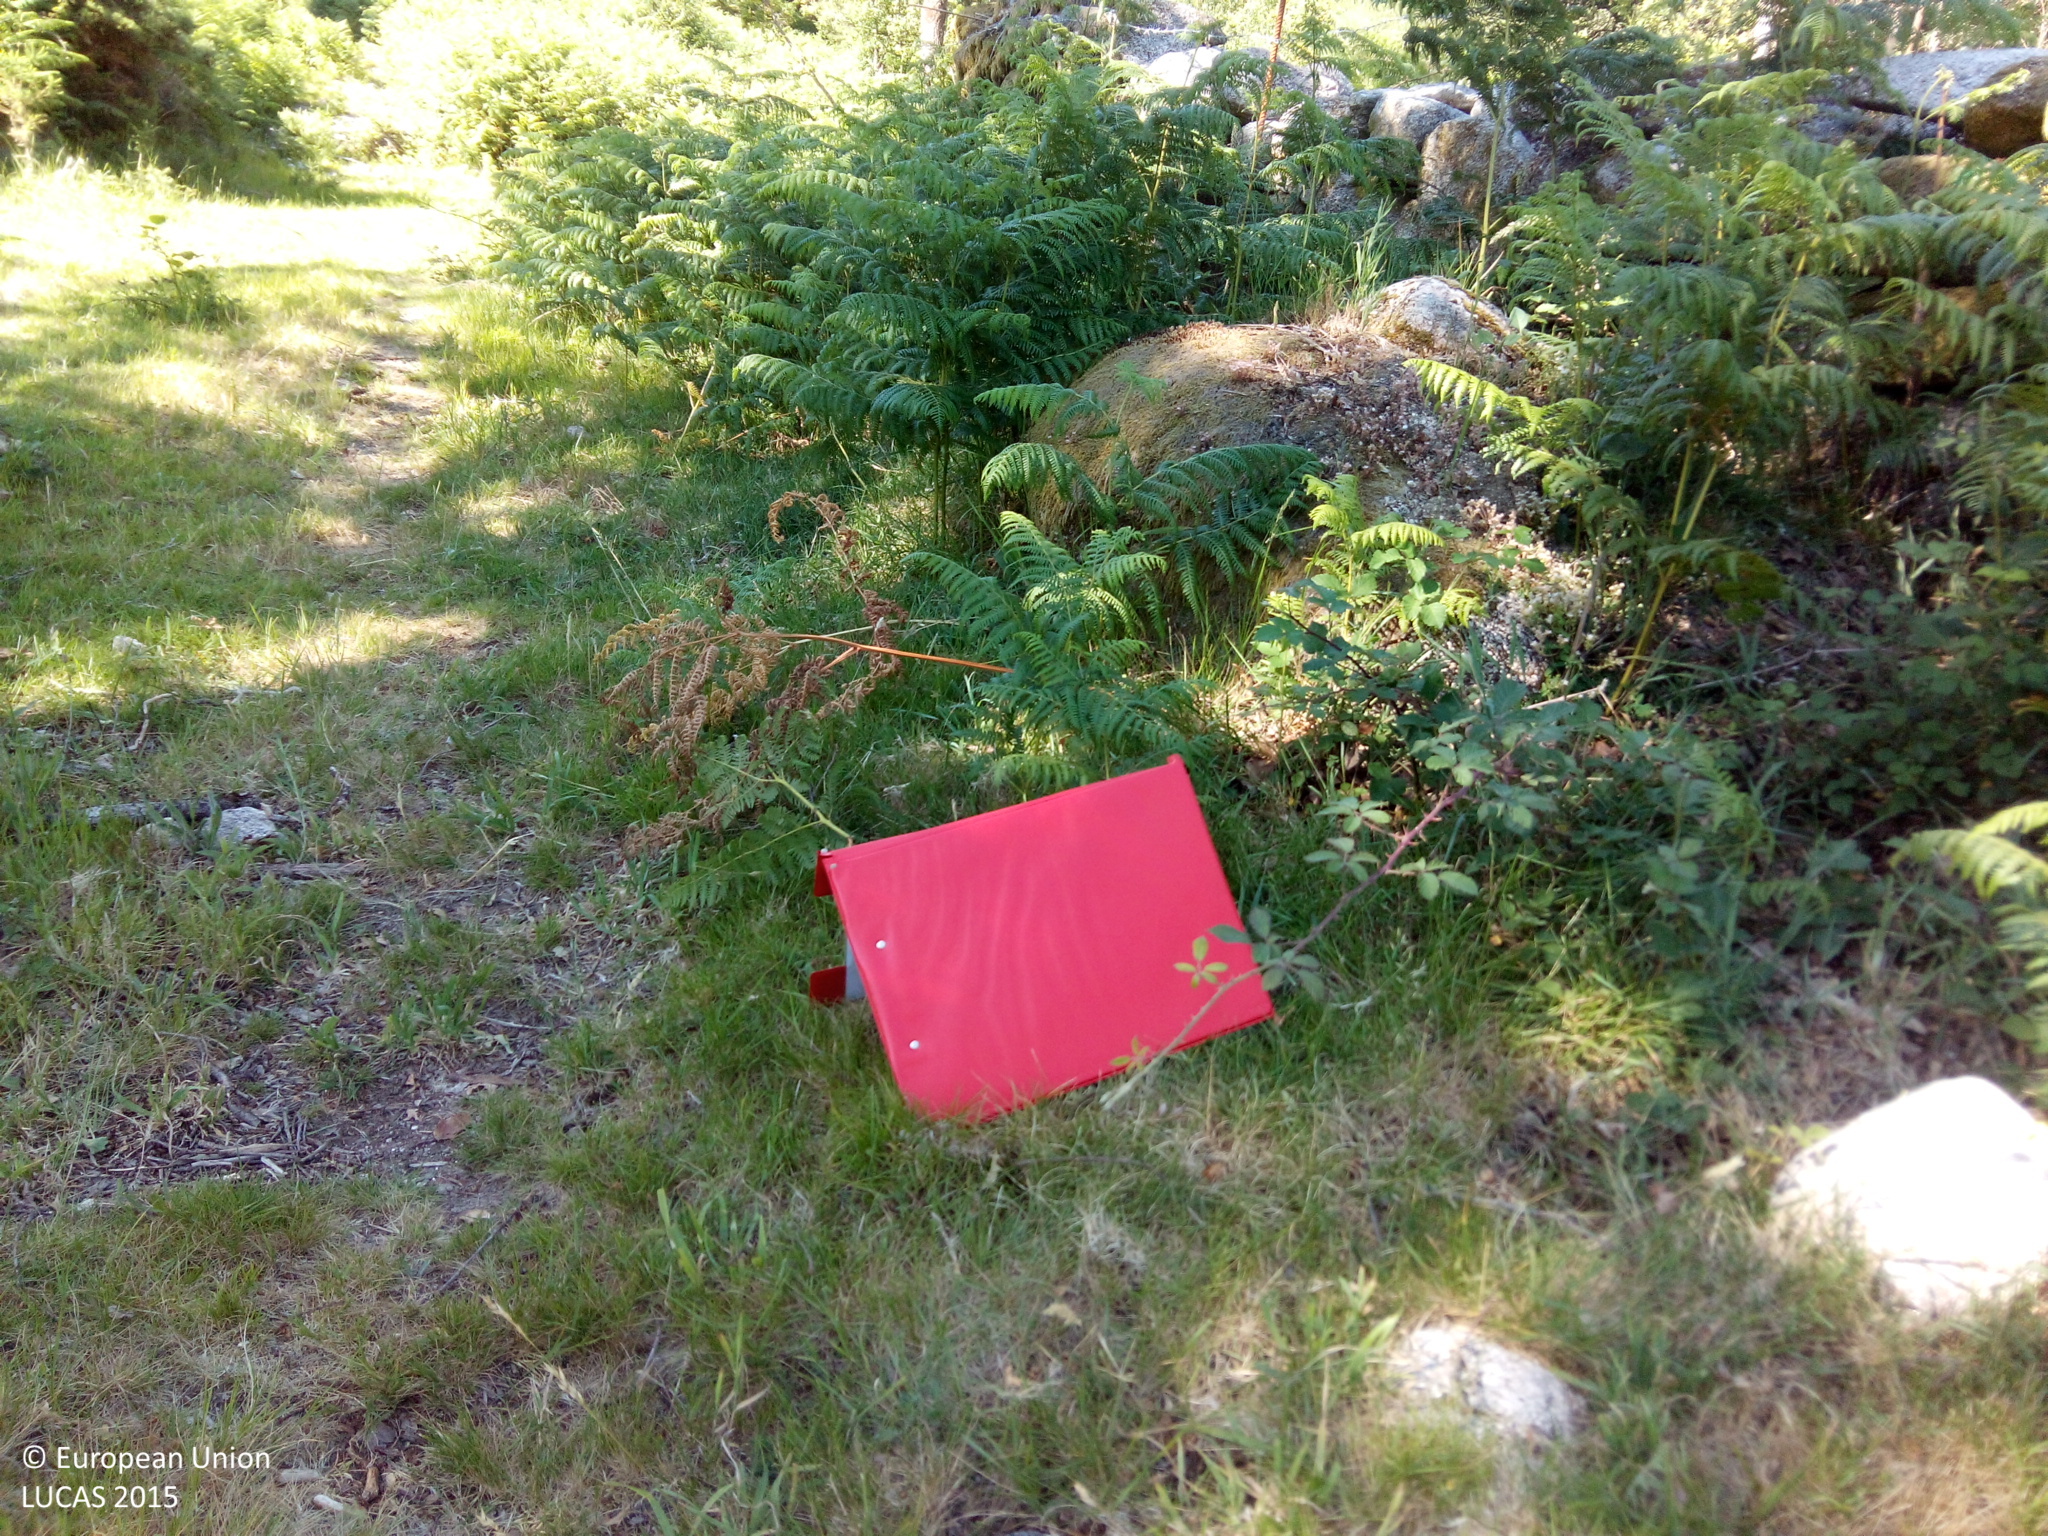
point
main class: Shrubland
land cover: Shrubland without tree cover
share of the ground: > 75 %
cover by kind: shrubs 100 %
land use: Abandoned areas
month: June
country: ES
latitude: 42.3571
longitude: -8.3891
